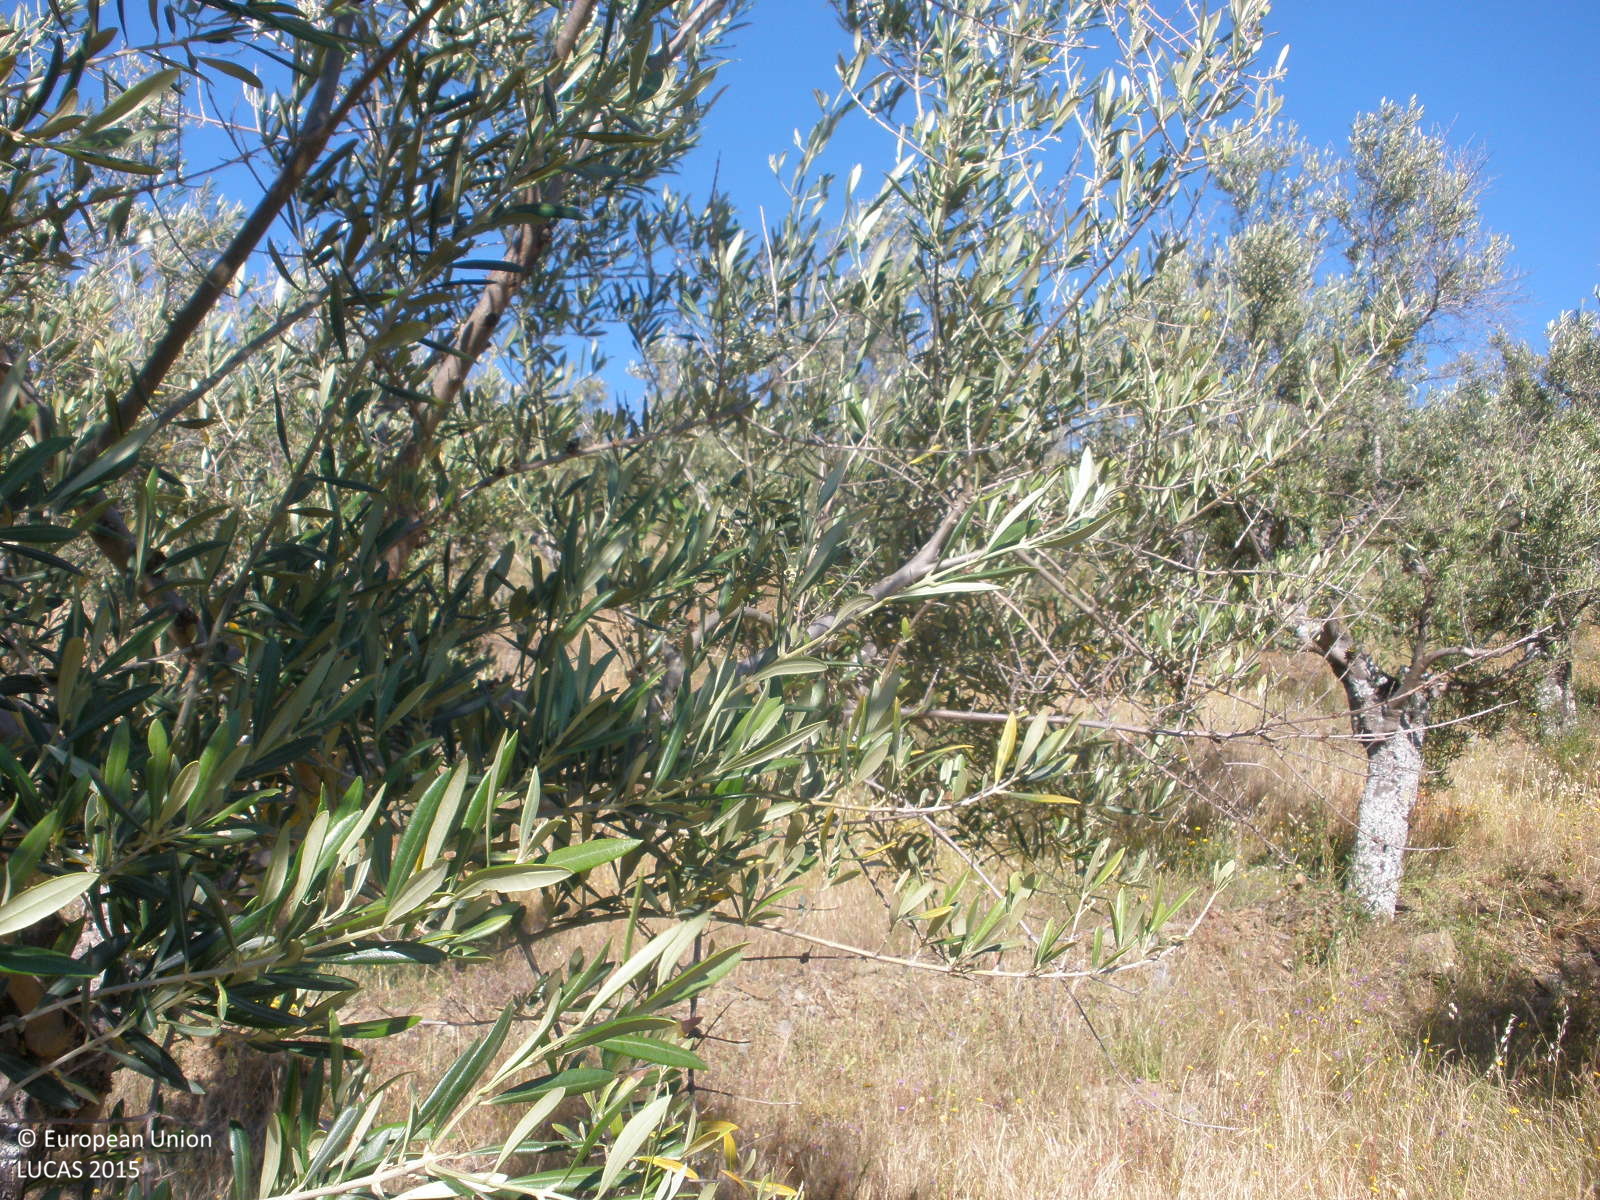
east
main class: Cropland
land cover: Olive groves
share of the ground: 50 - 75 %
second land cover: Spontaneously vegetated surfaces
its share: > 75 %
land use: Agriculture (excluding fallow land and kitchen gardens)
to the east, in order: Olive groves; Spontaneously vegetated surfaces; Tracks; Shrubland without tree cover; Dry stone walls; Olive groves; Tracks; Shruby margins; Dry stone walls; Olive groves
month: May
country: ES
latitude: 40.2905
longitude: -6.2054
